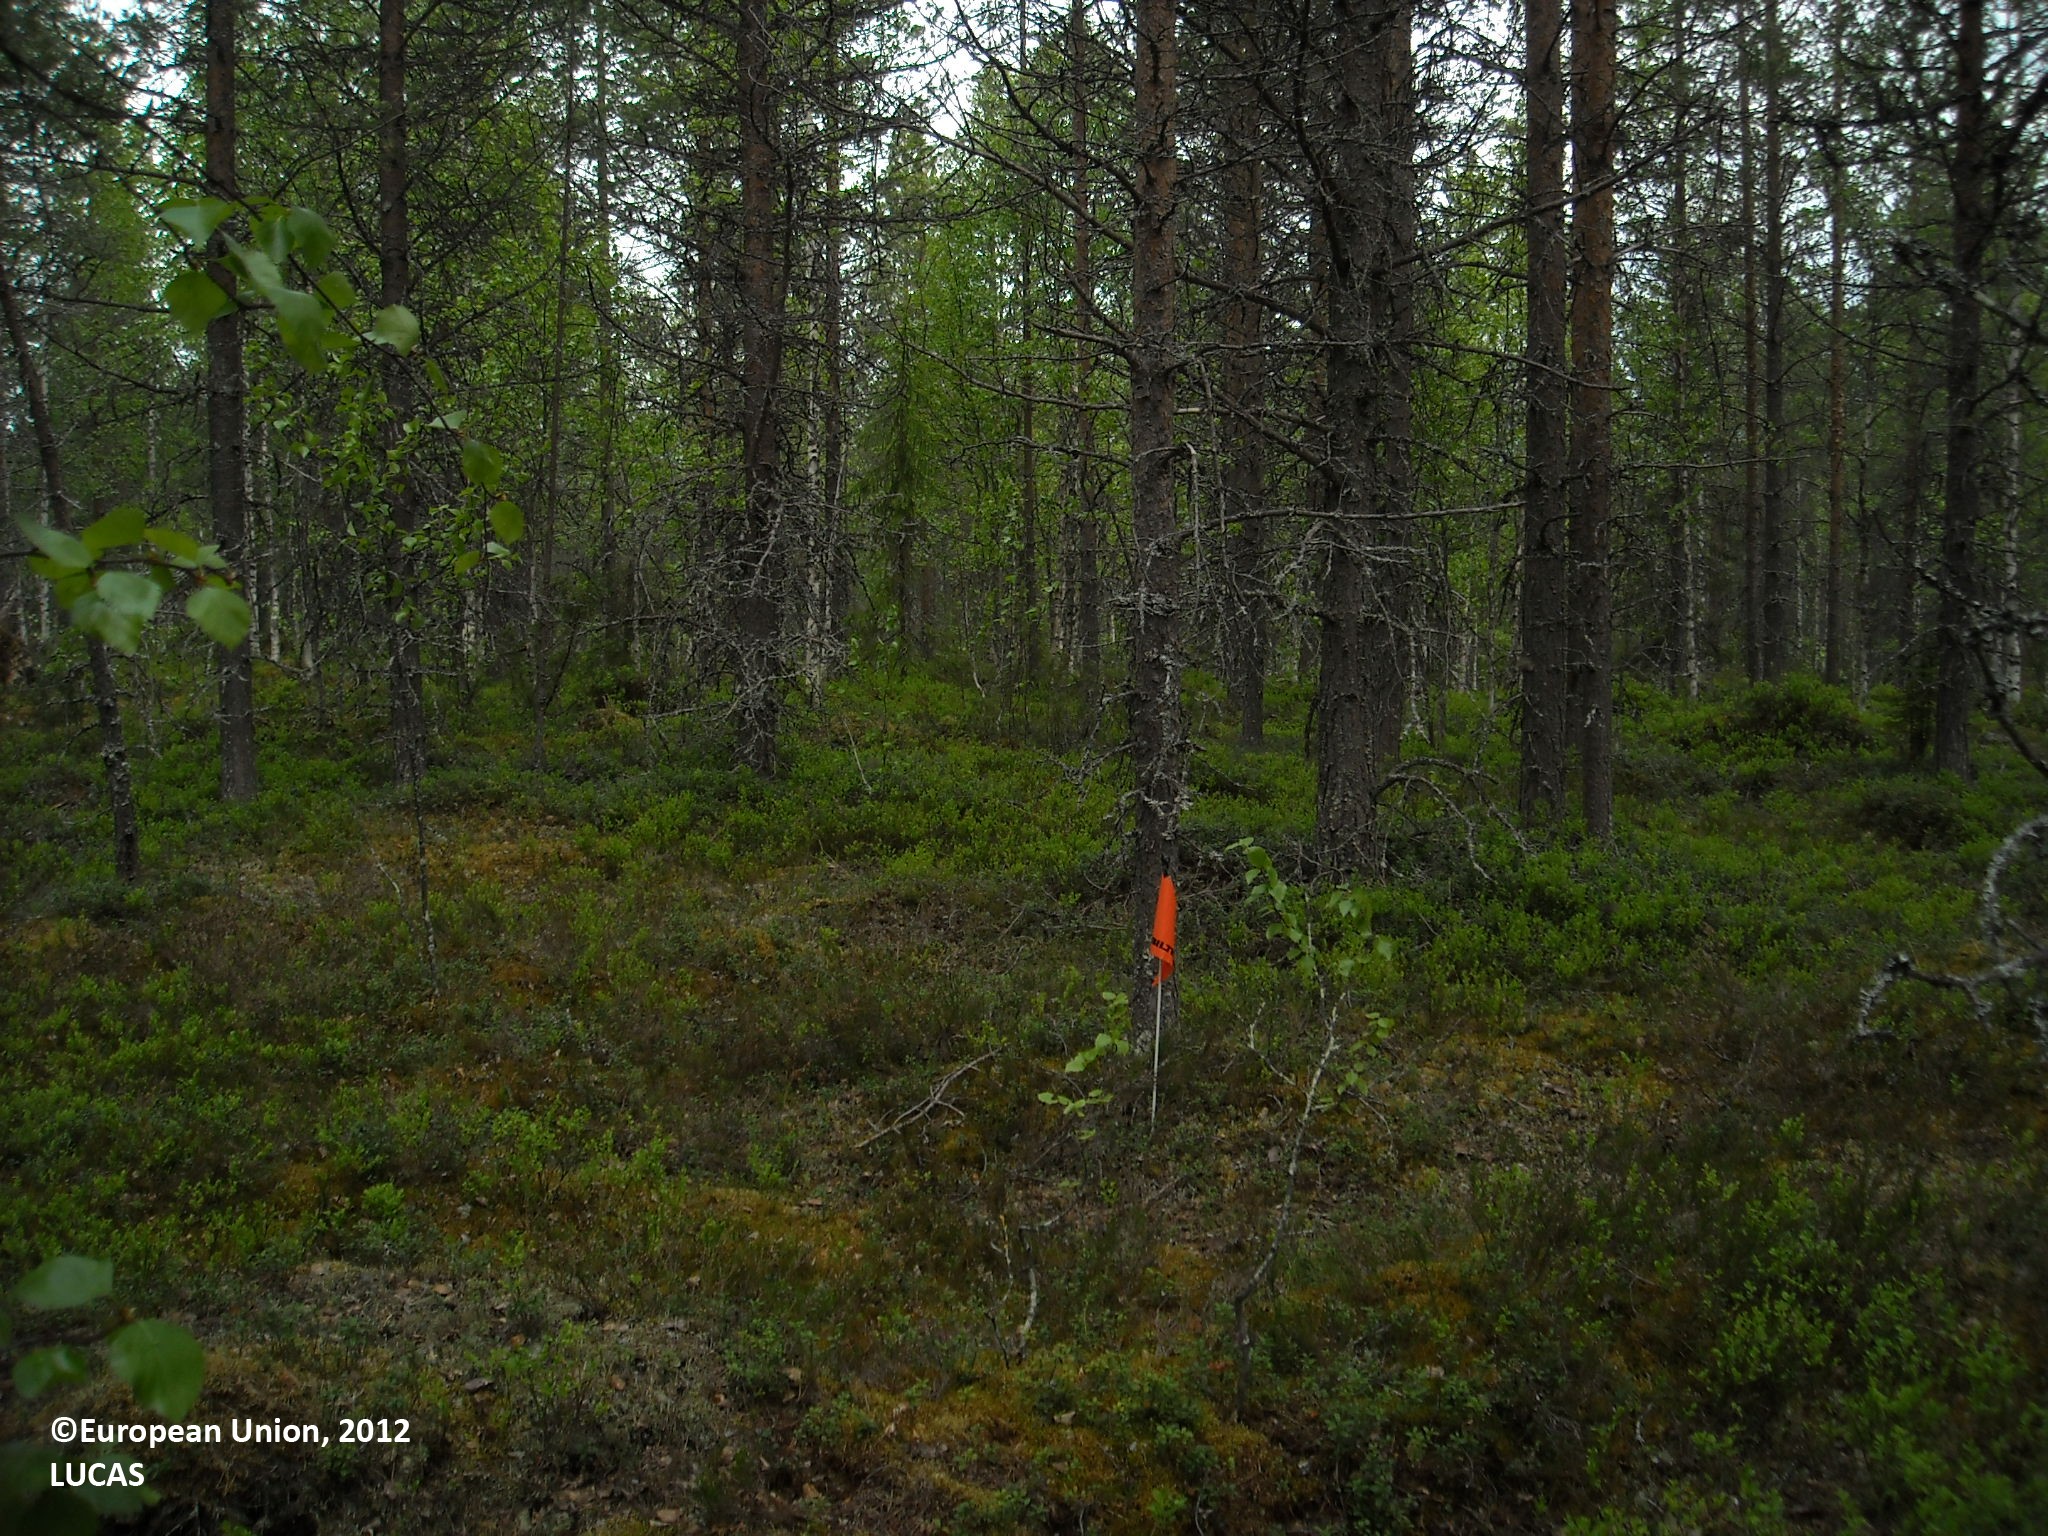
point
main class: Woodland
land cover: Pine dominated mixed woodland
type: boreal forest
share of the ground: > 75 %
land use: Forestry
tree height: > 5 m
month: June
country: FI
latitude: 65.5723
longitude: 28.0233
